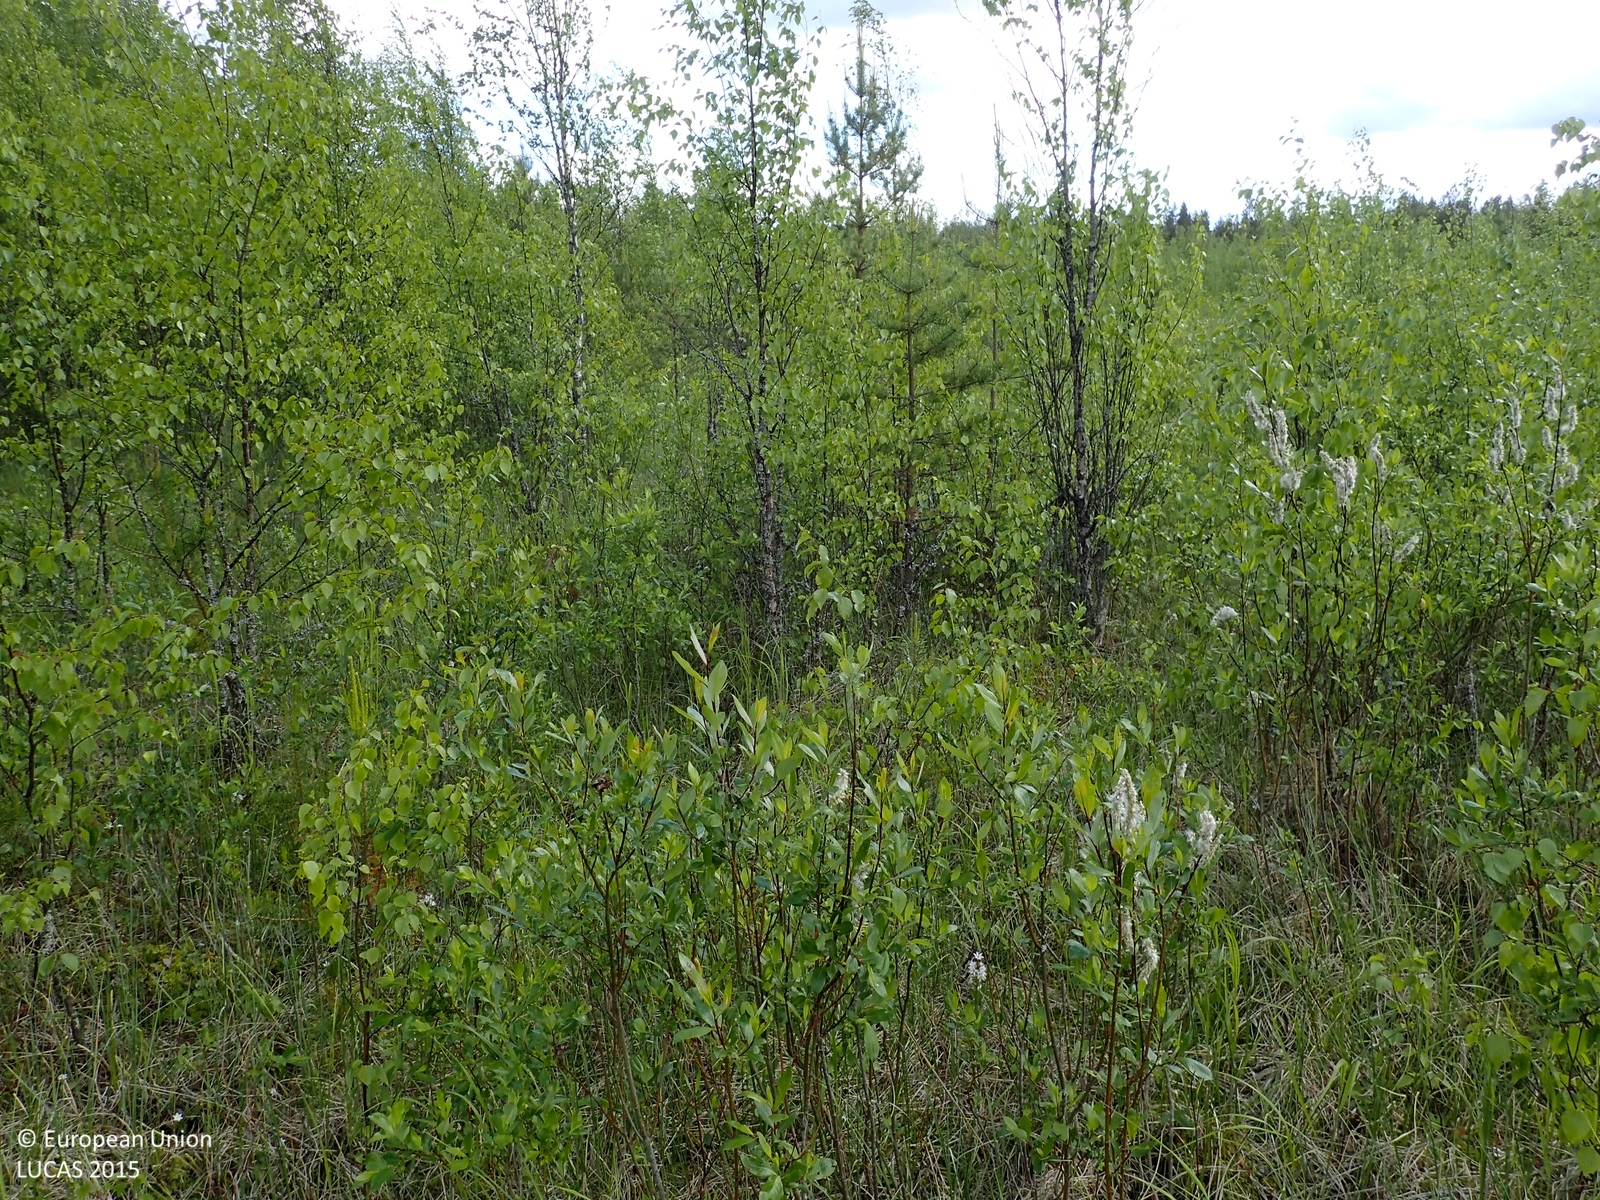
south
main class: Woodland
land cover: Pine dominated mixed woodland
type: mire and swamp forests
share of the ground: 10 - 25 %
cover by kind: herbaceous plants 70 %, broadleaved forest trees 10 %, shrubs 10 %, coniferous forest trees 5 %, lichens and mosses 5 %
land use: Forestry
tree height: < 5 m
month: June
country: FI
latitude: 62.5986
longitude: 23.1728
